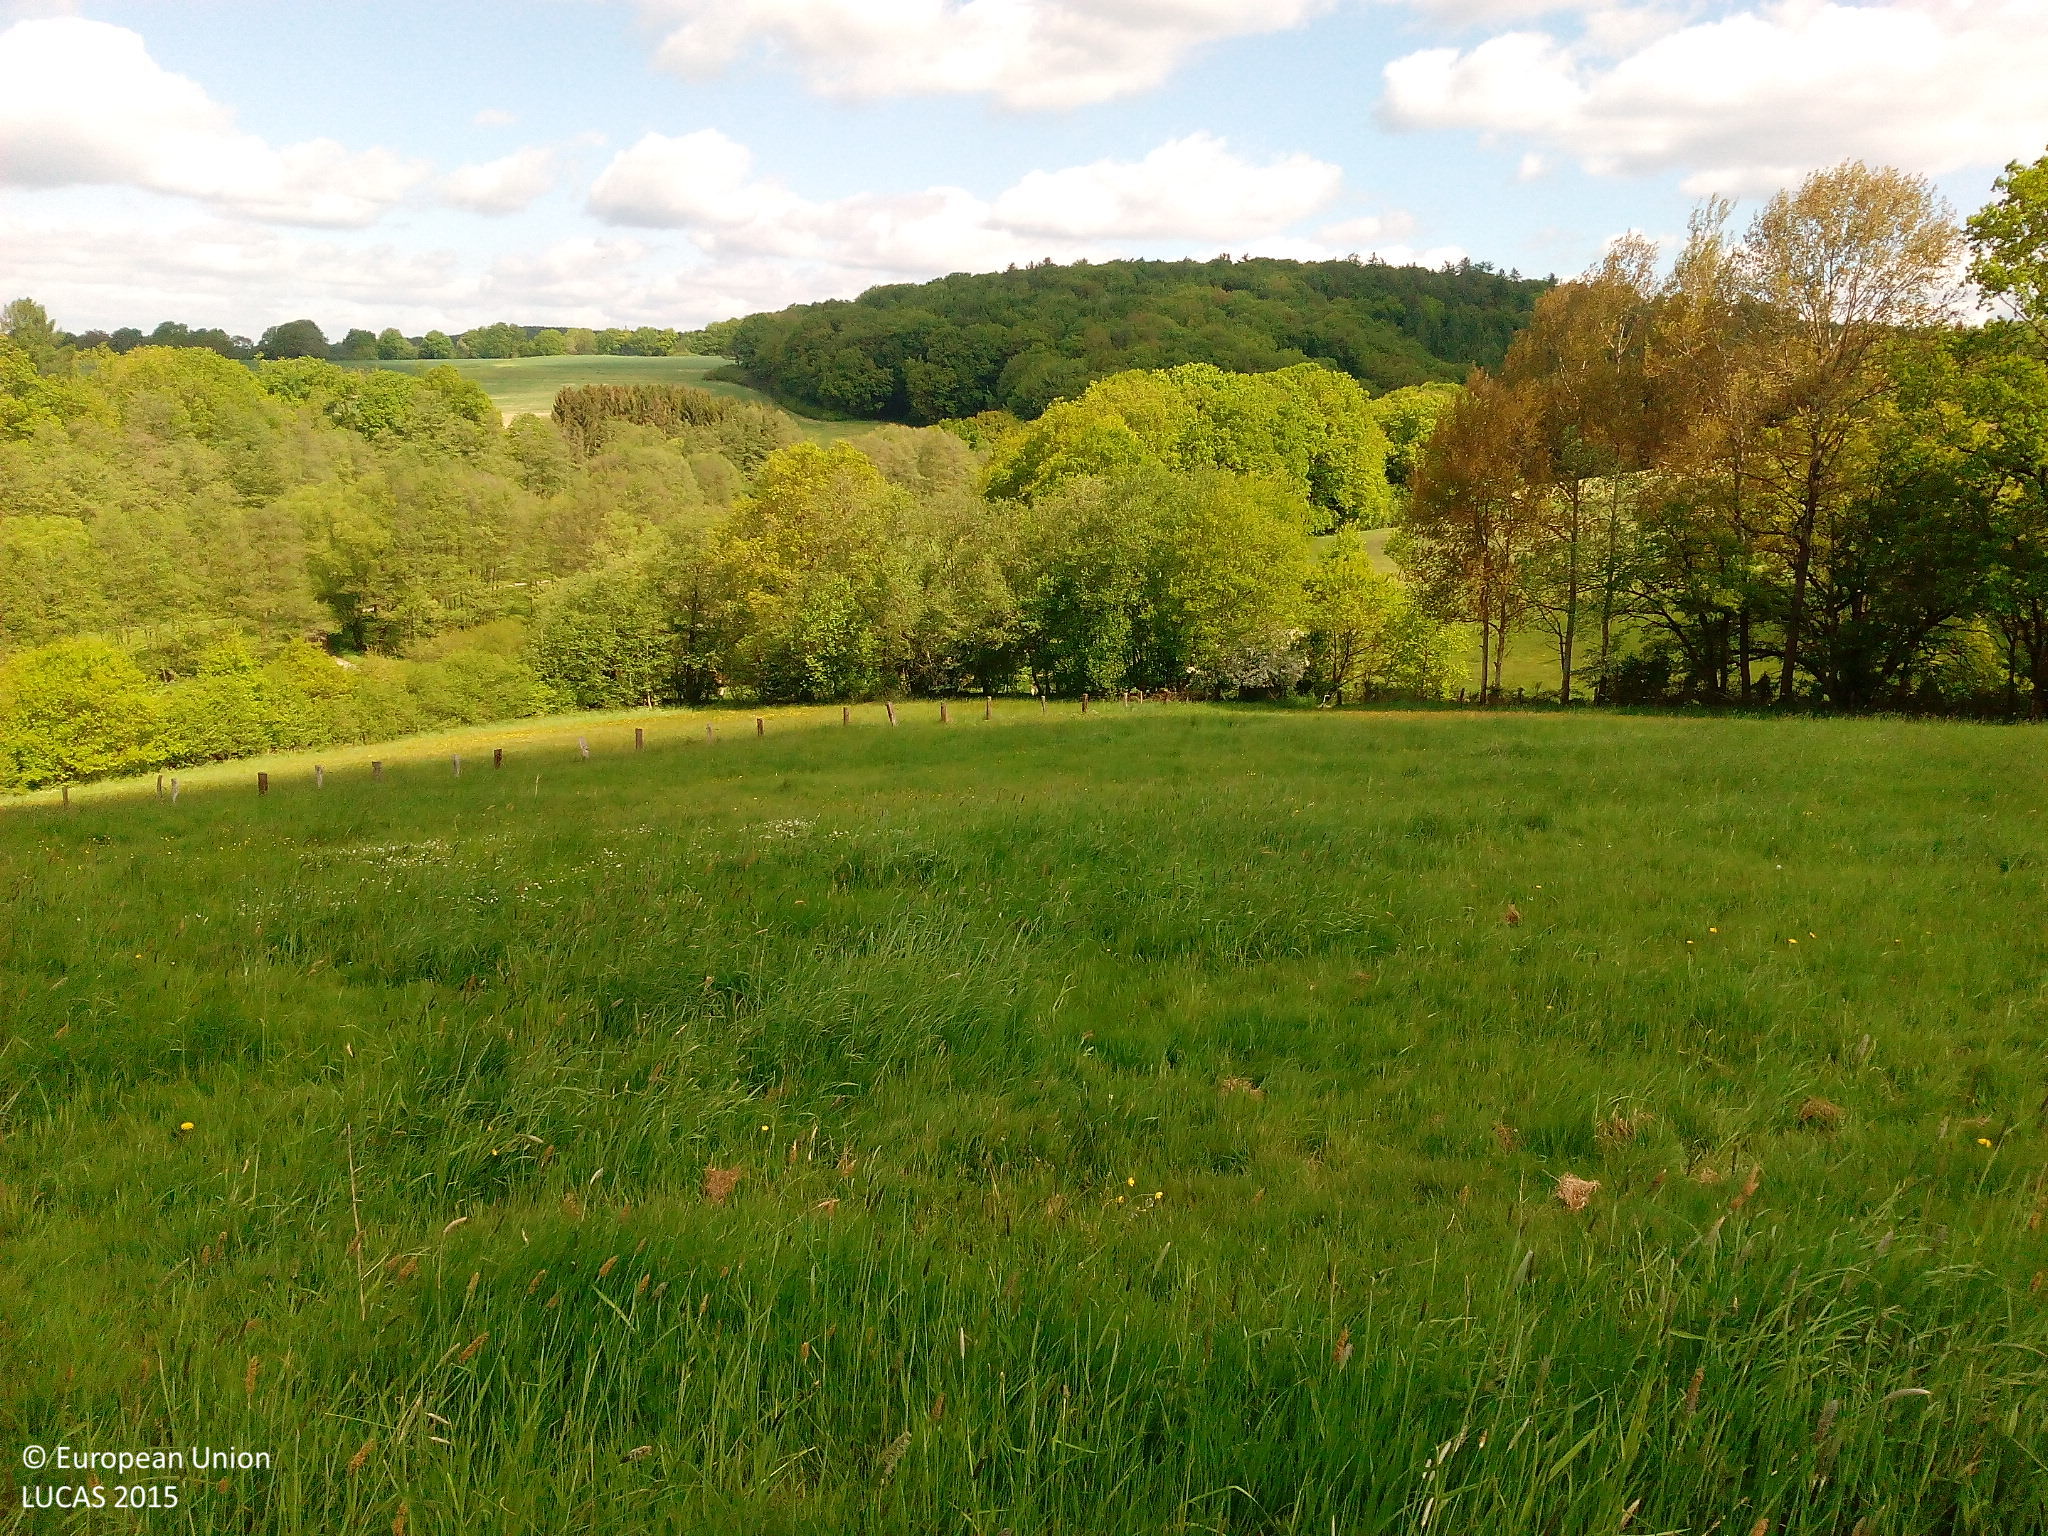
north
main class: Grassland
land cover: Grassland without tree/shrub cover
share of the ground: > 75 %
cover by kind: herbaceous plants 100 %
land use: Agriculture (excluding fallow land and kitchen gardens)
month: May
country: DE
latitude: 51.3344
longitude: 9.6413
